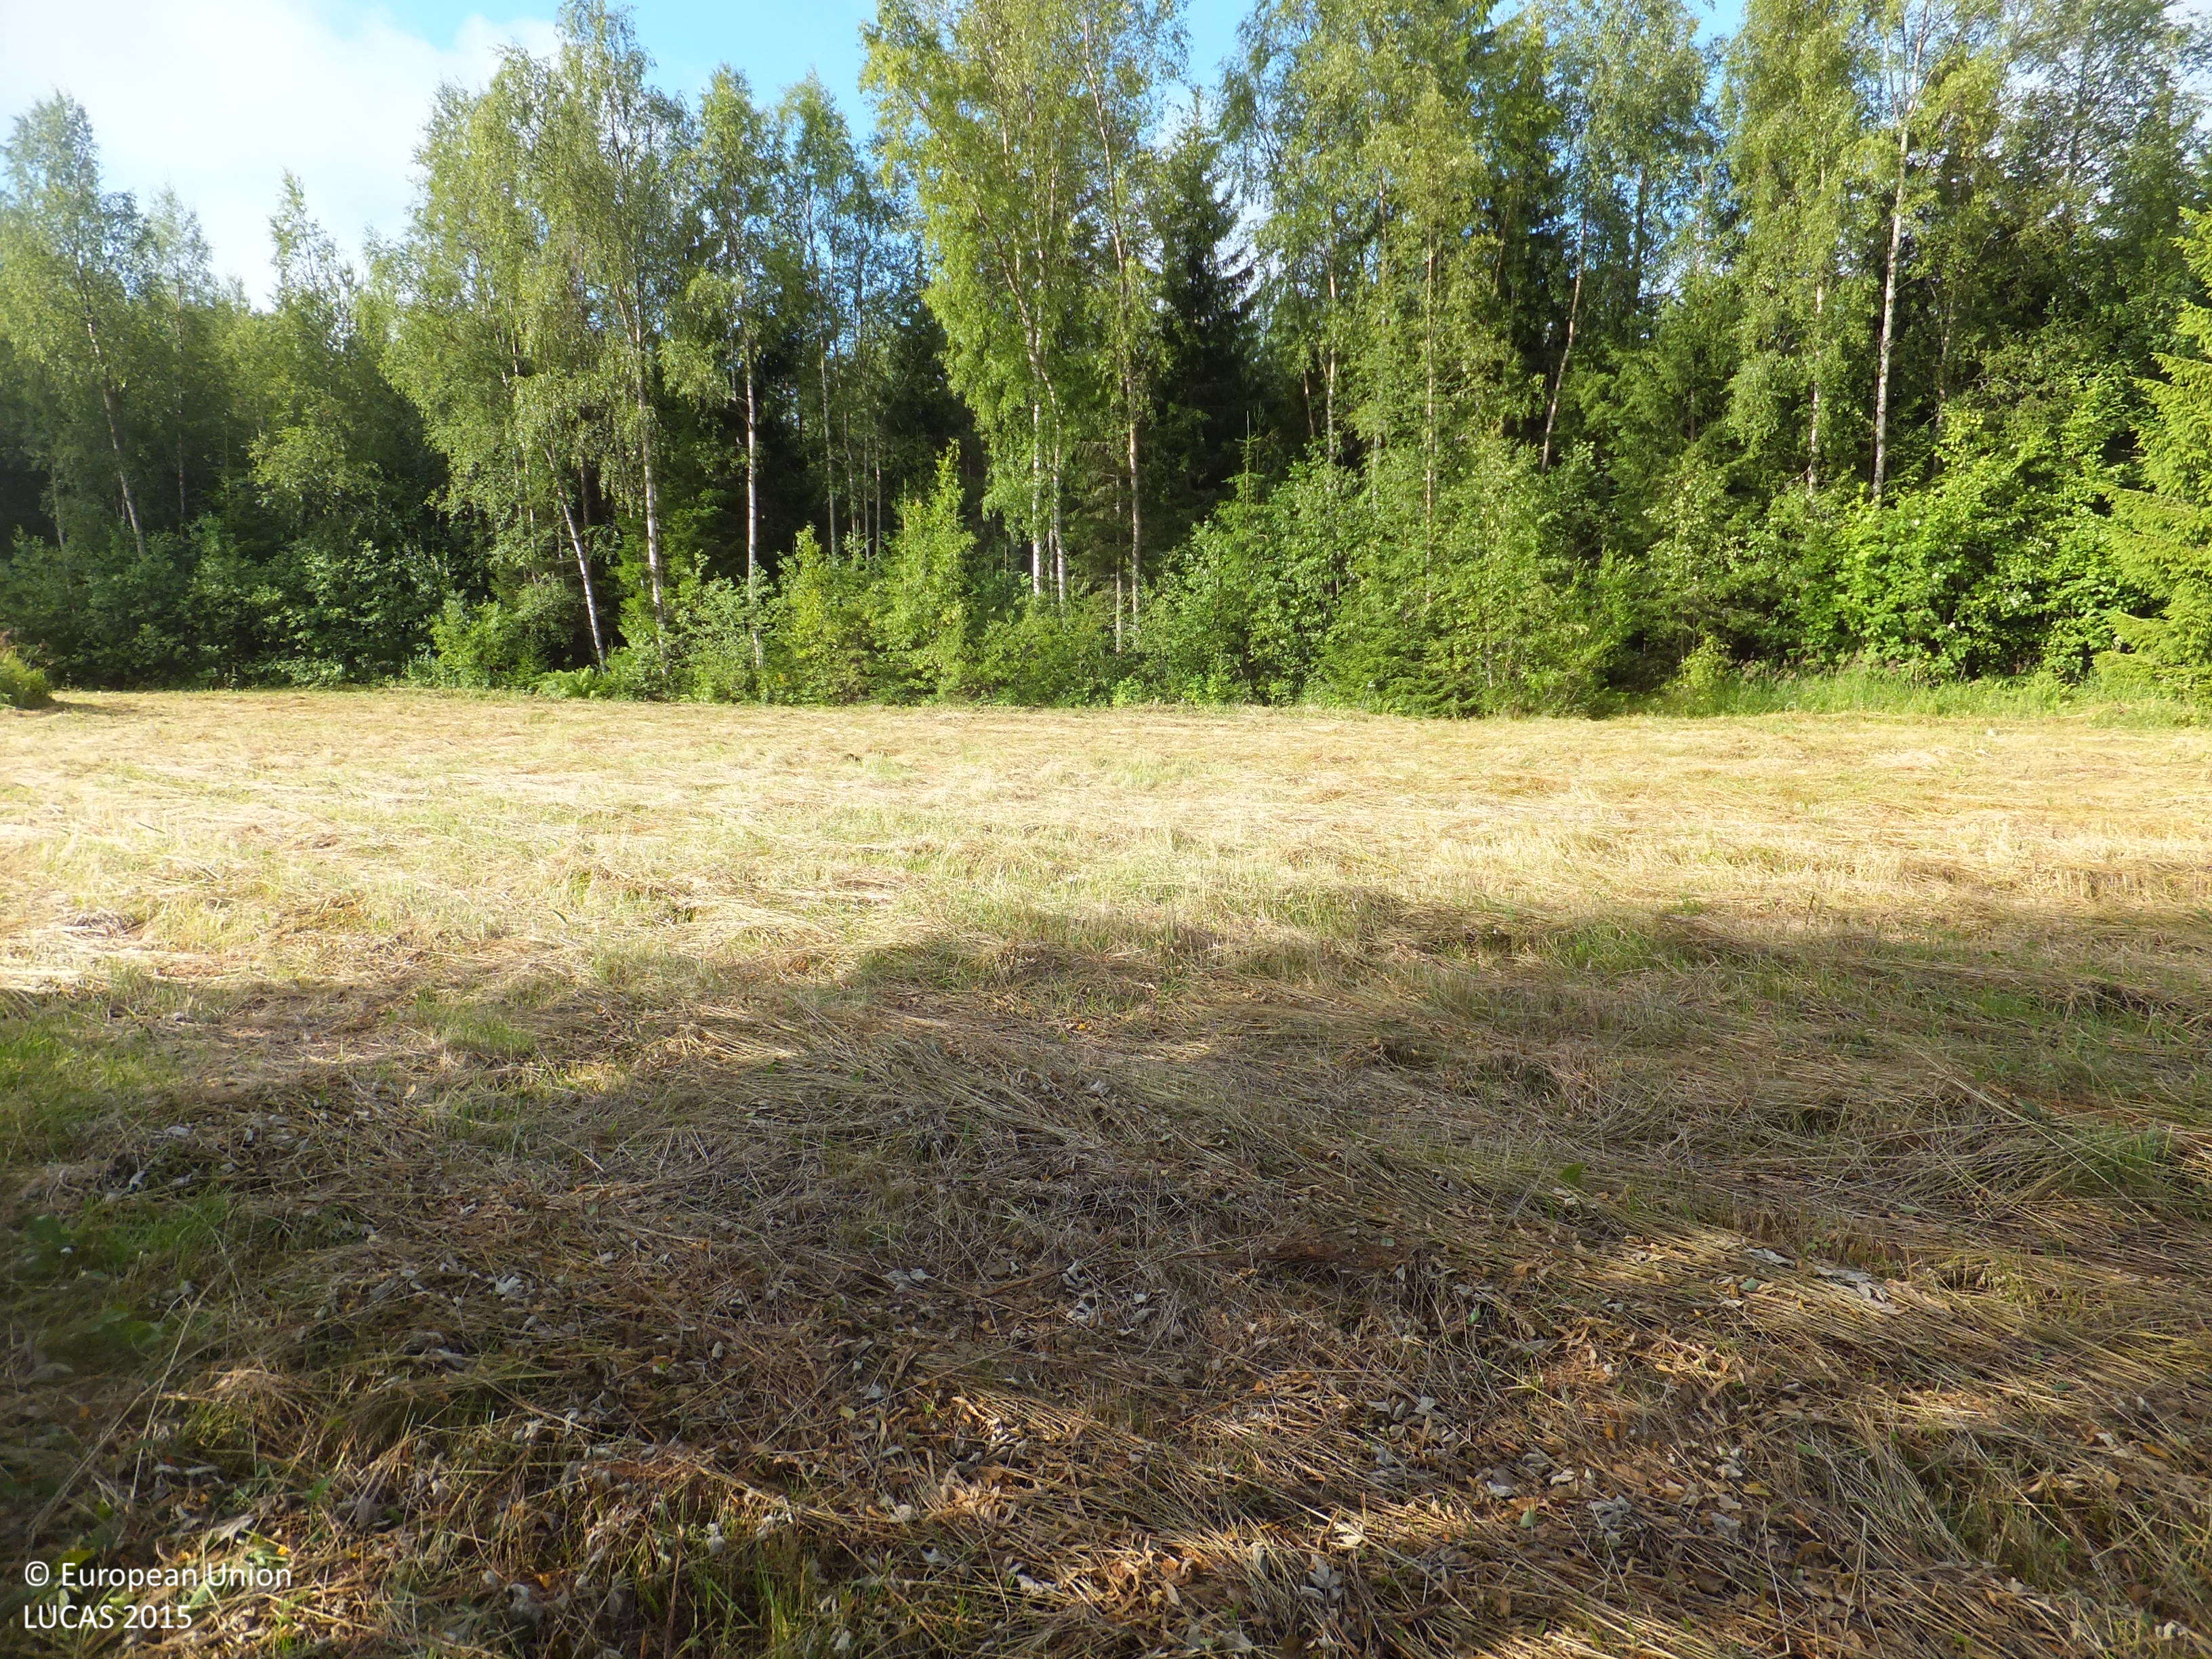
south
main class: Grassland
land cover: Grassland without tree/shrub cover
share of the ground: > 75 %
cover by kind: herbaceous plants 100 %
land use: Agriculture (excluding fallow land and kitchen gardens)
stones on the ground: < 10 %
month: July
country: FI
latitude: 63.1422
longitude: 21.6866
